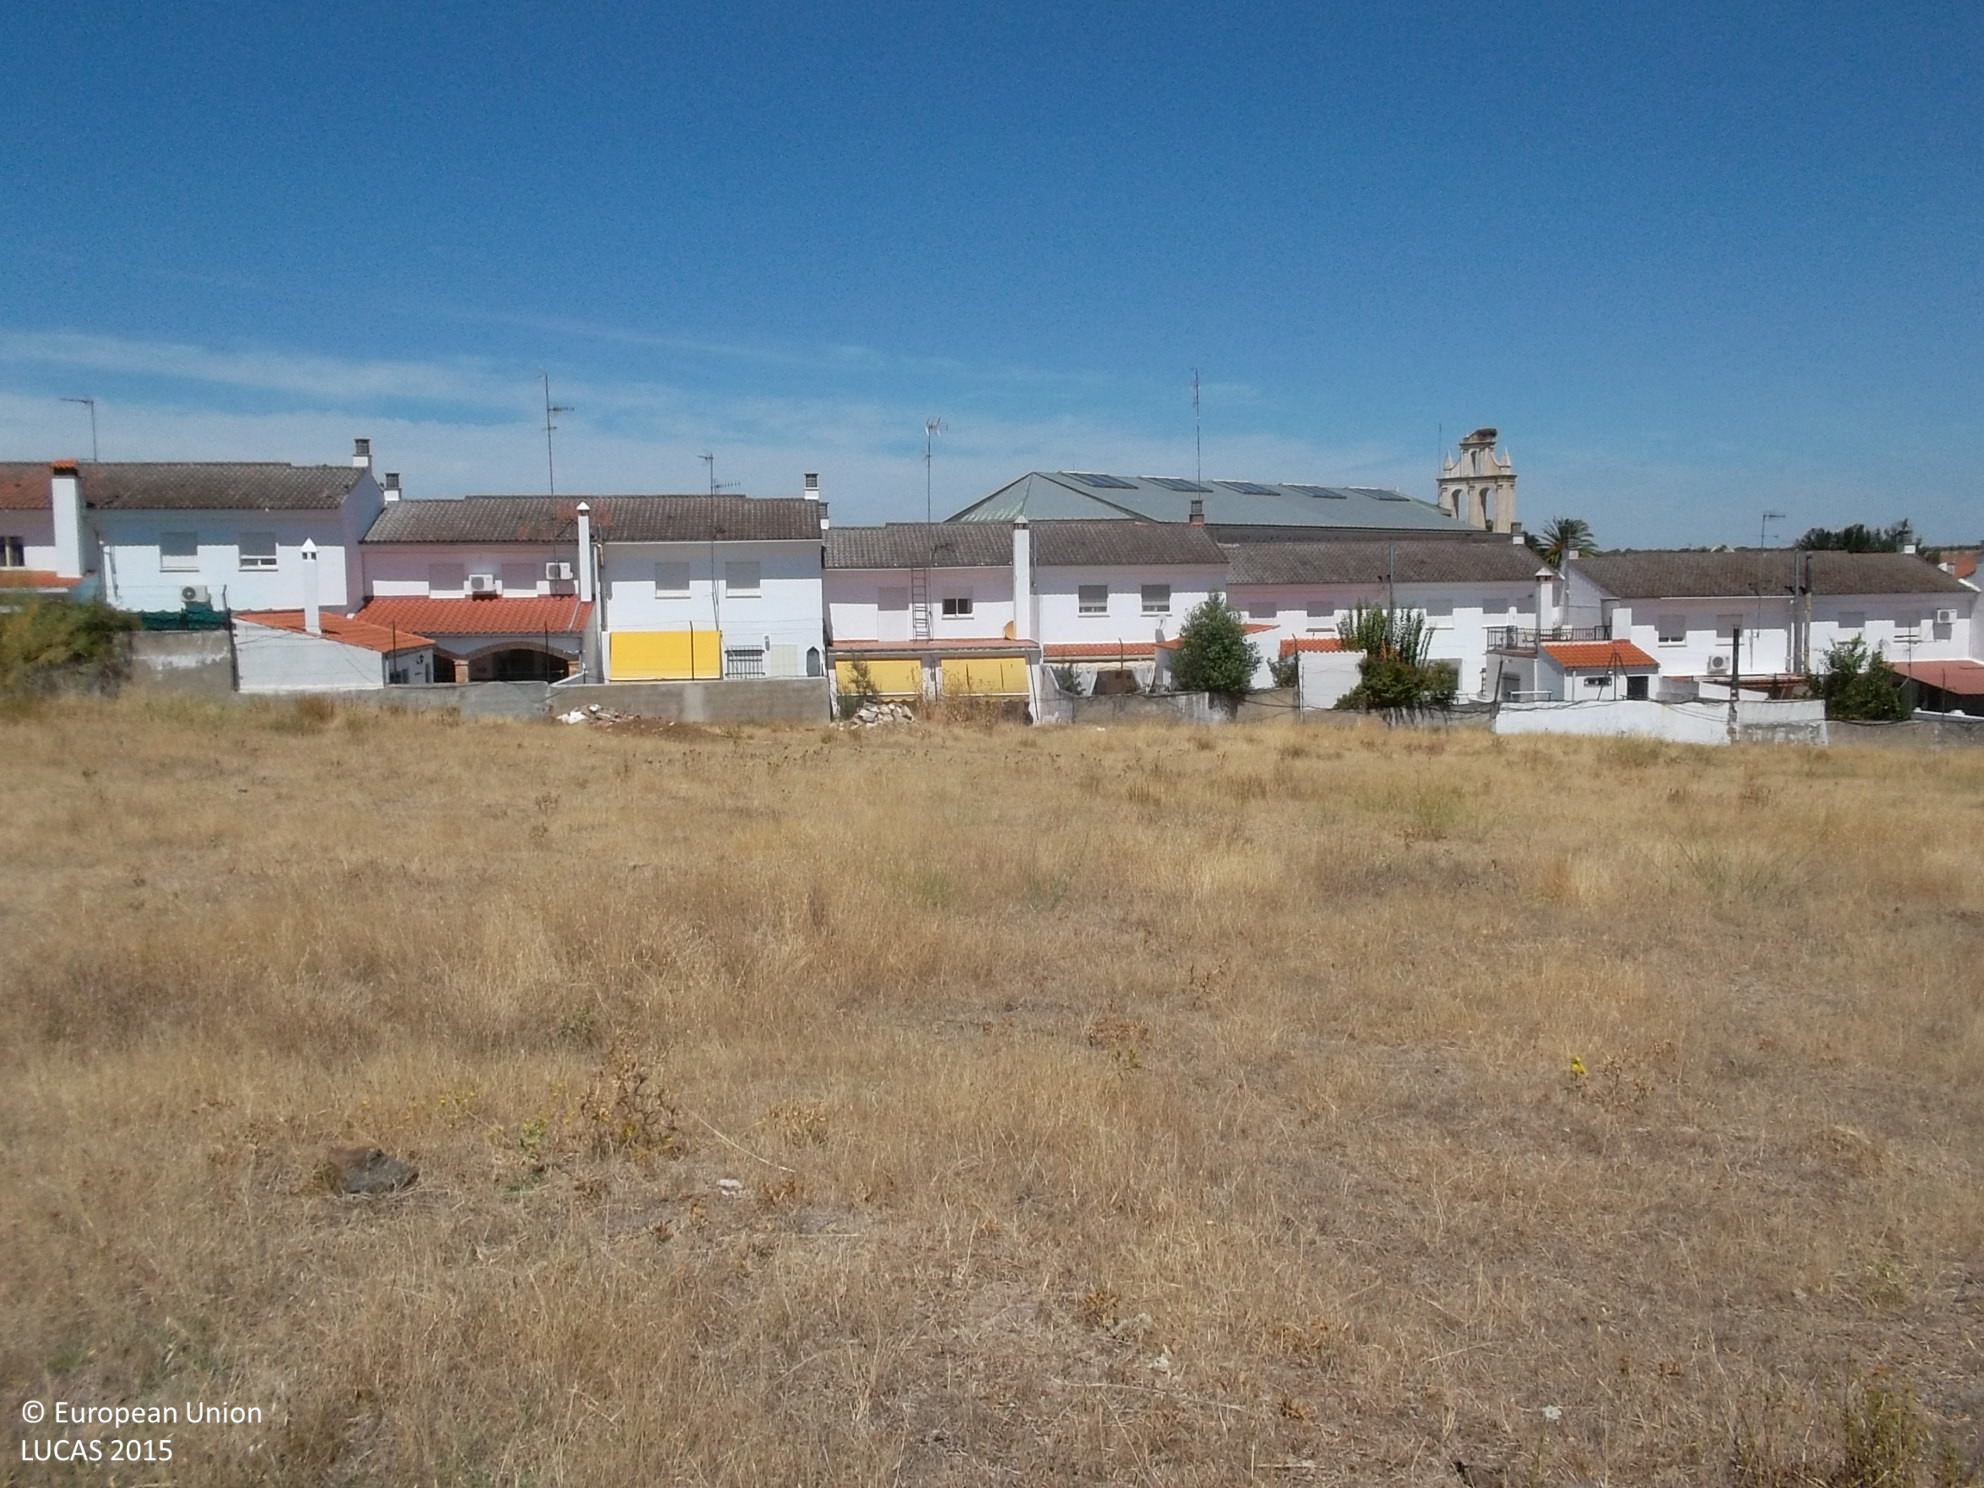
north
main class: Grassland
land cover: Spontaneously vegetated surfaces
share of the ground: > 75 %
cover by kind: herbaceous plants 100 %
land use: Fallow land
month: August
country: ES
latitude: 38.1681
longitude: -6.6579
